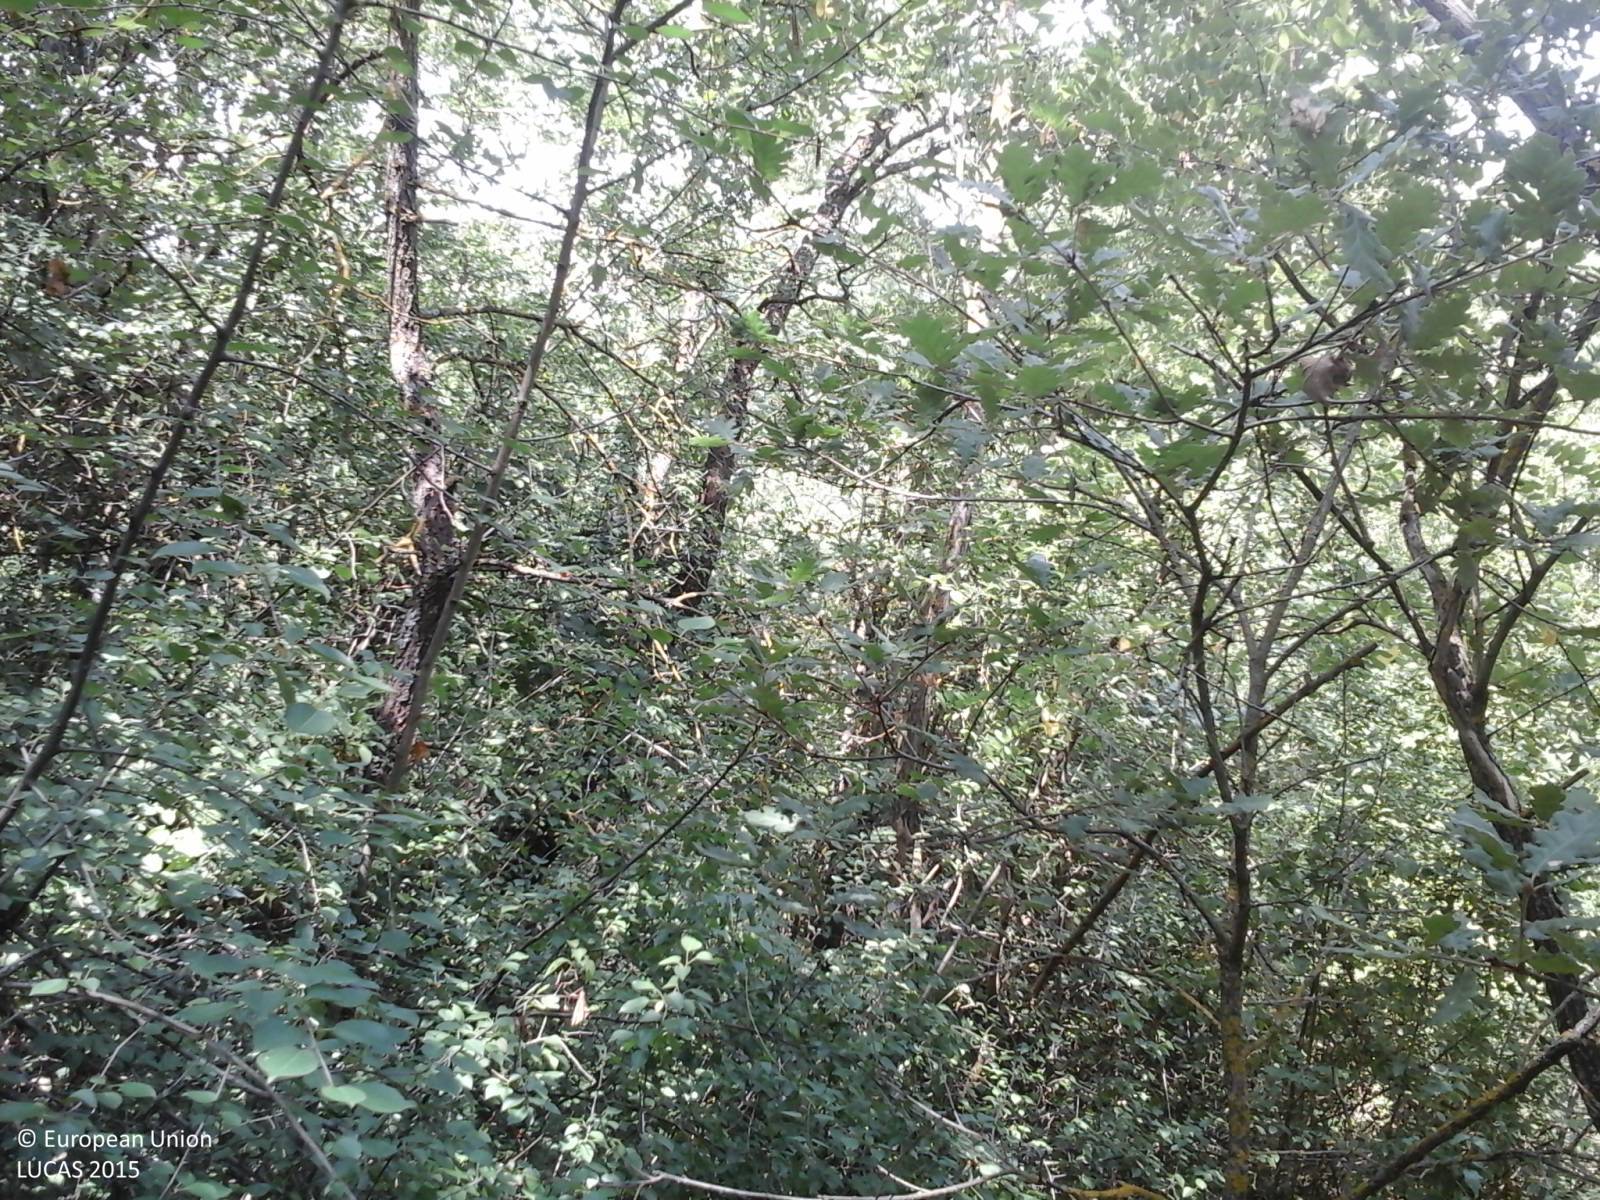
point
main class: Woodland
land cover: Broadleaved woodland
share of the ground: > 75 %
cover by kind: broadleaved forest trees 100 %
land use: Semi-natural and natural areas not in use
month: July
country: IT
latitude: 42.3258
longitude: 13.3989
